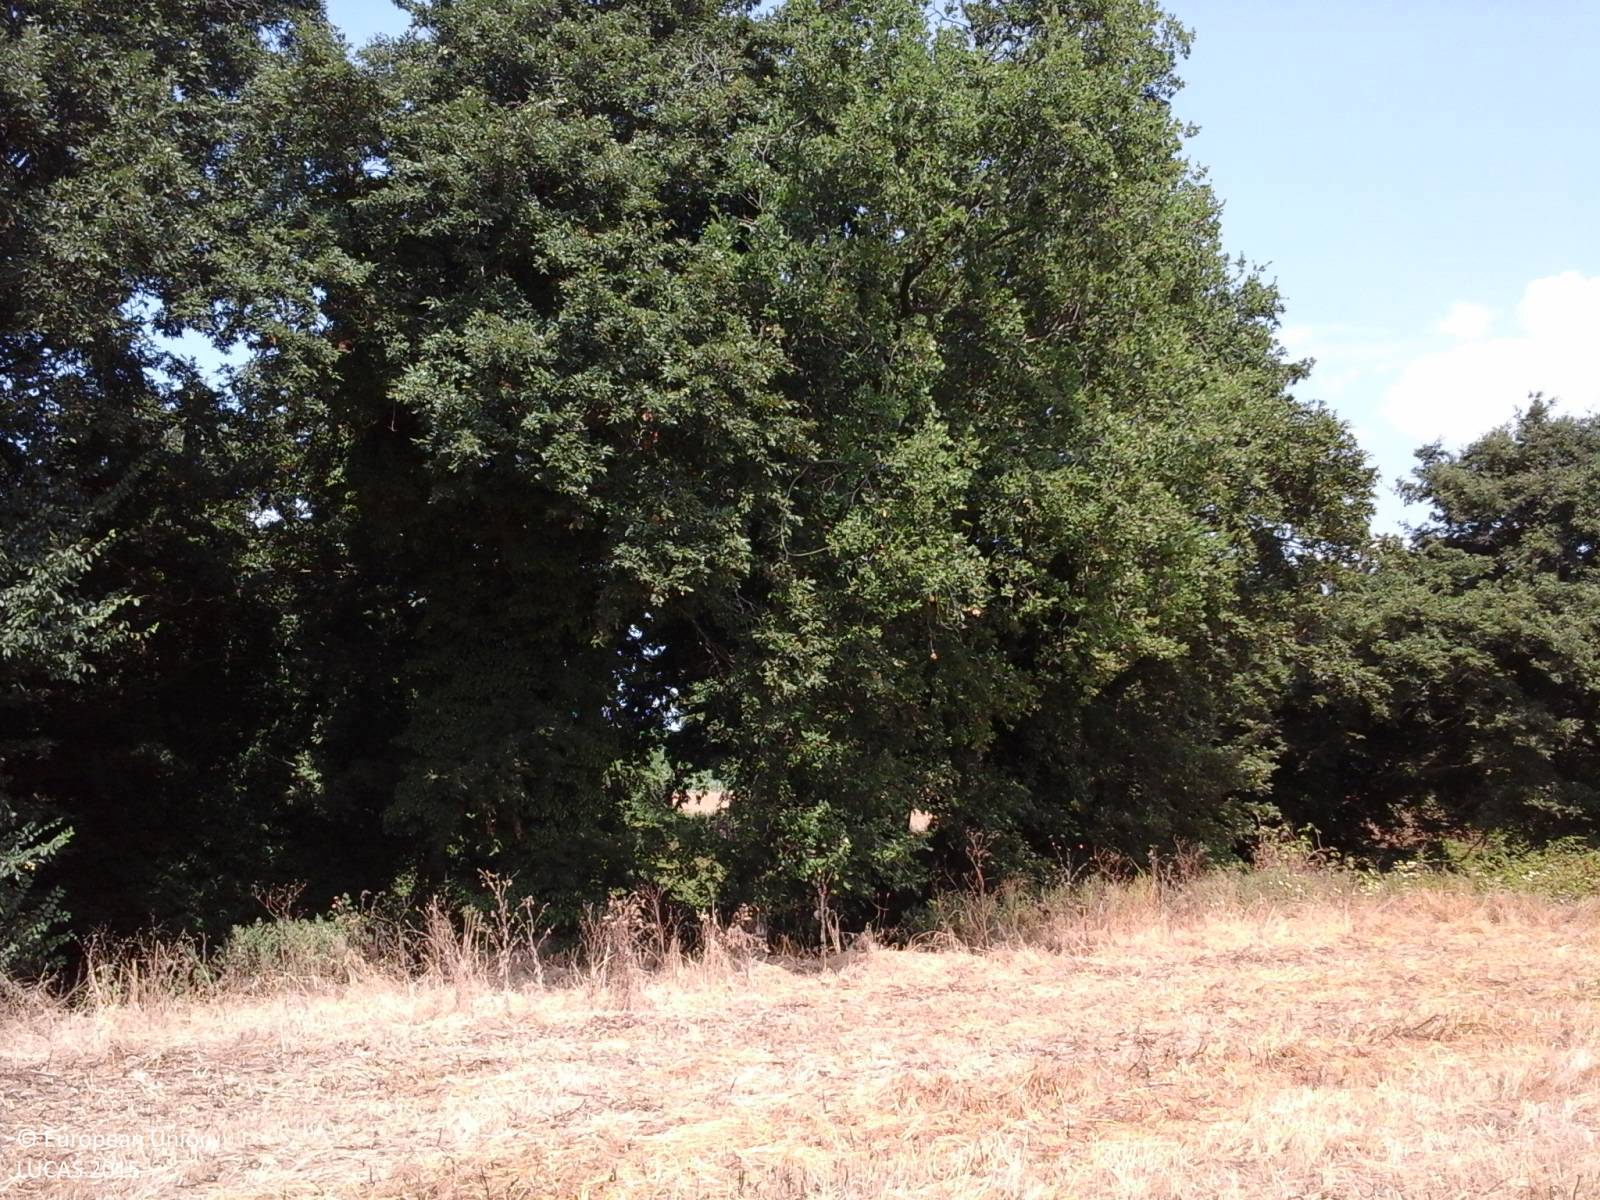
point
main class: Woodland
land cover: Broadleaved woodland
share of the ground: > 75 %
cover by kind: broadleaved forest trees 100 %
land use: Semi-natural and natural areas not in use
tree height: > 5 m
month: July
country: IT
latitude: 41.9976
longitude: 12.2011
